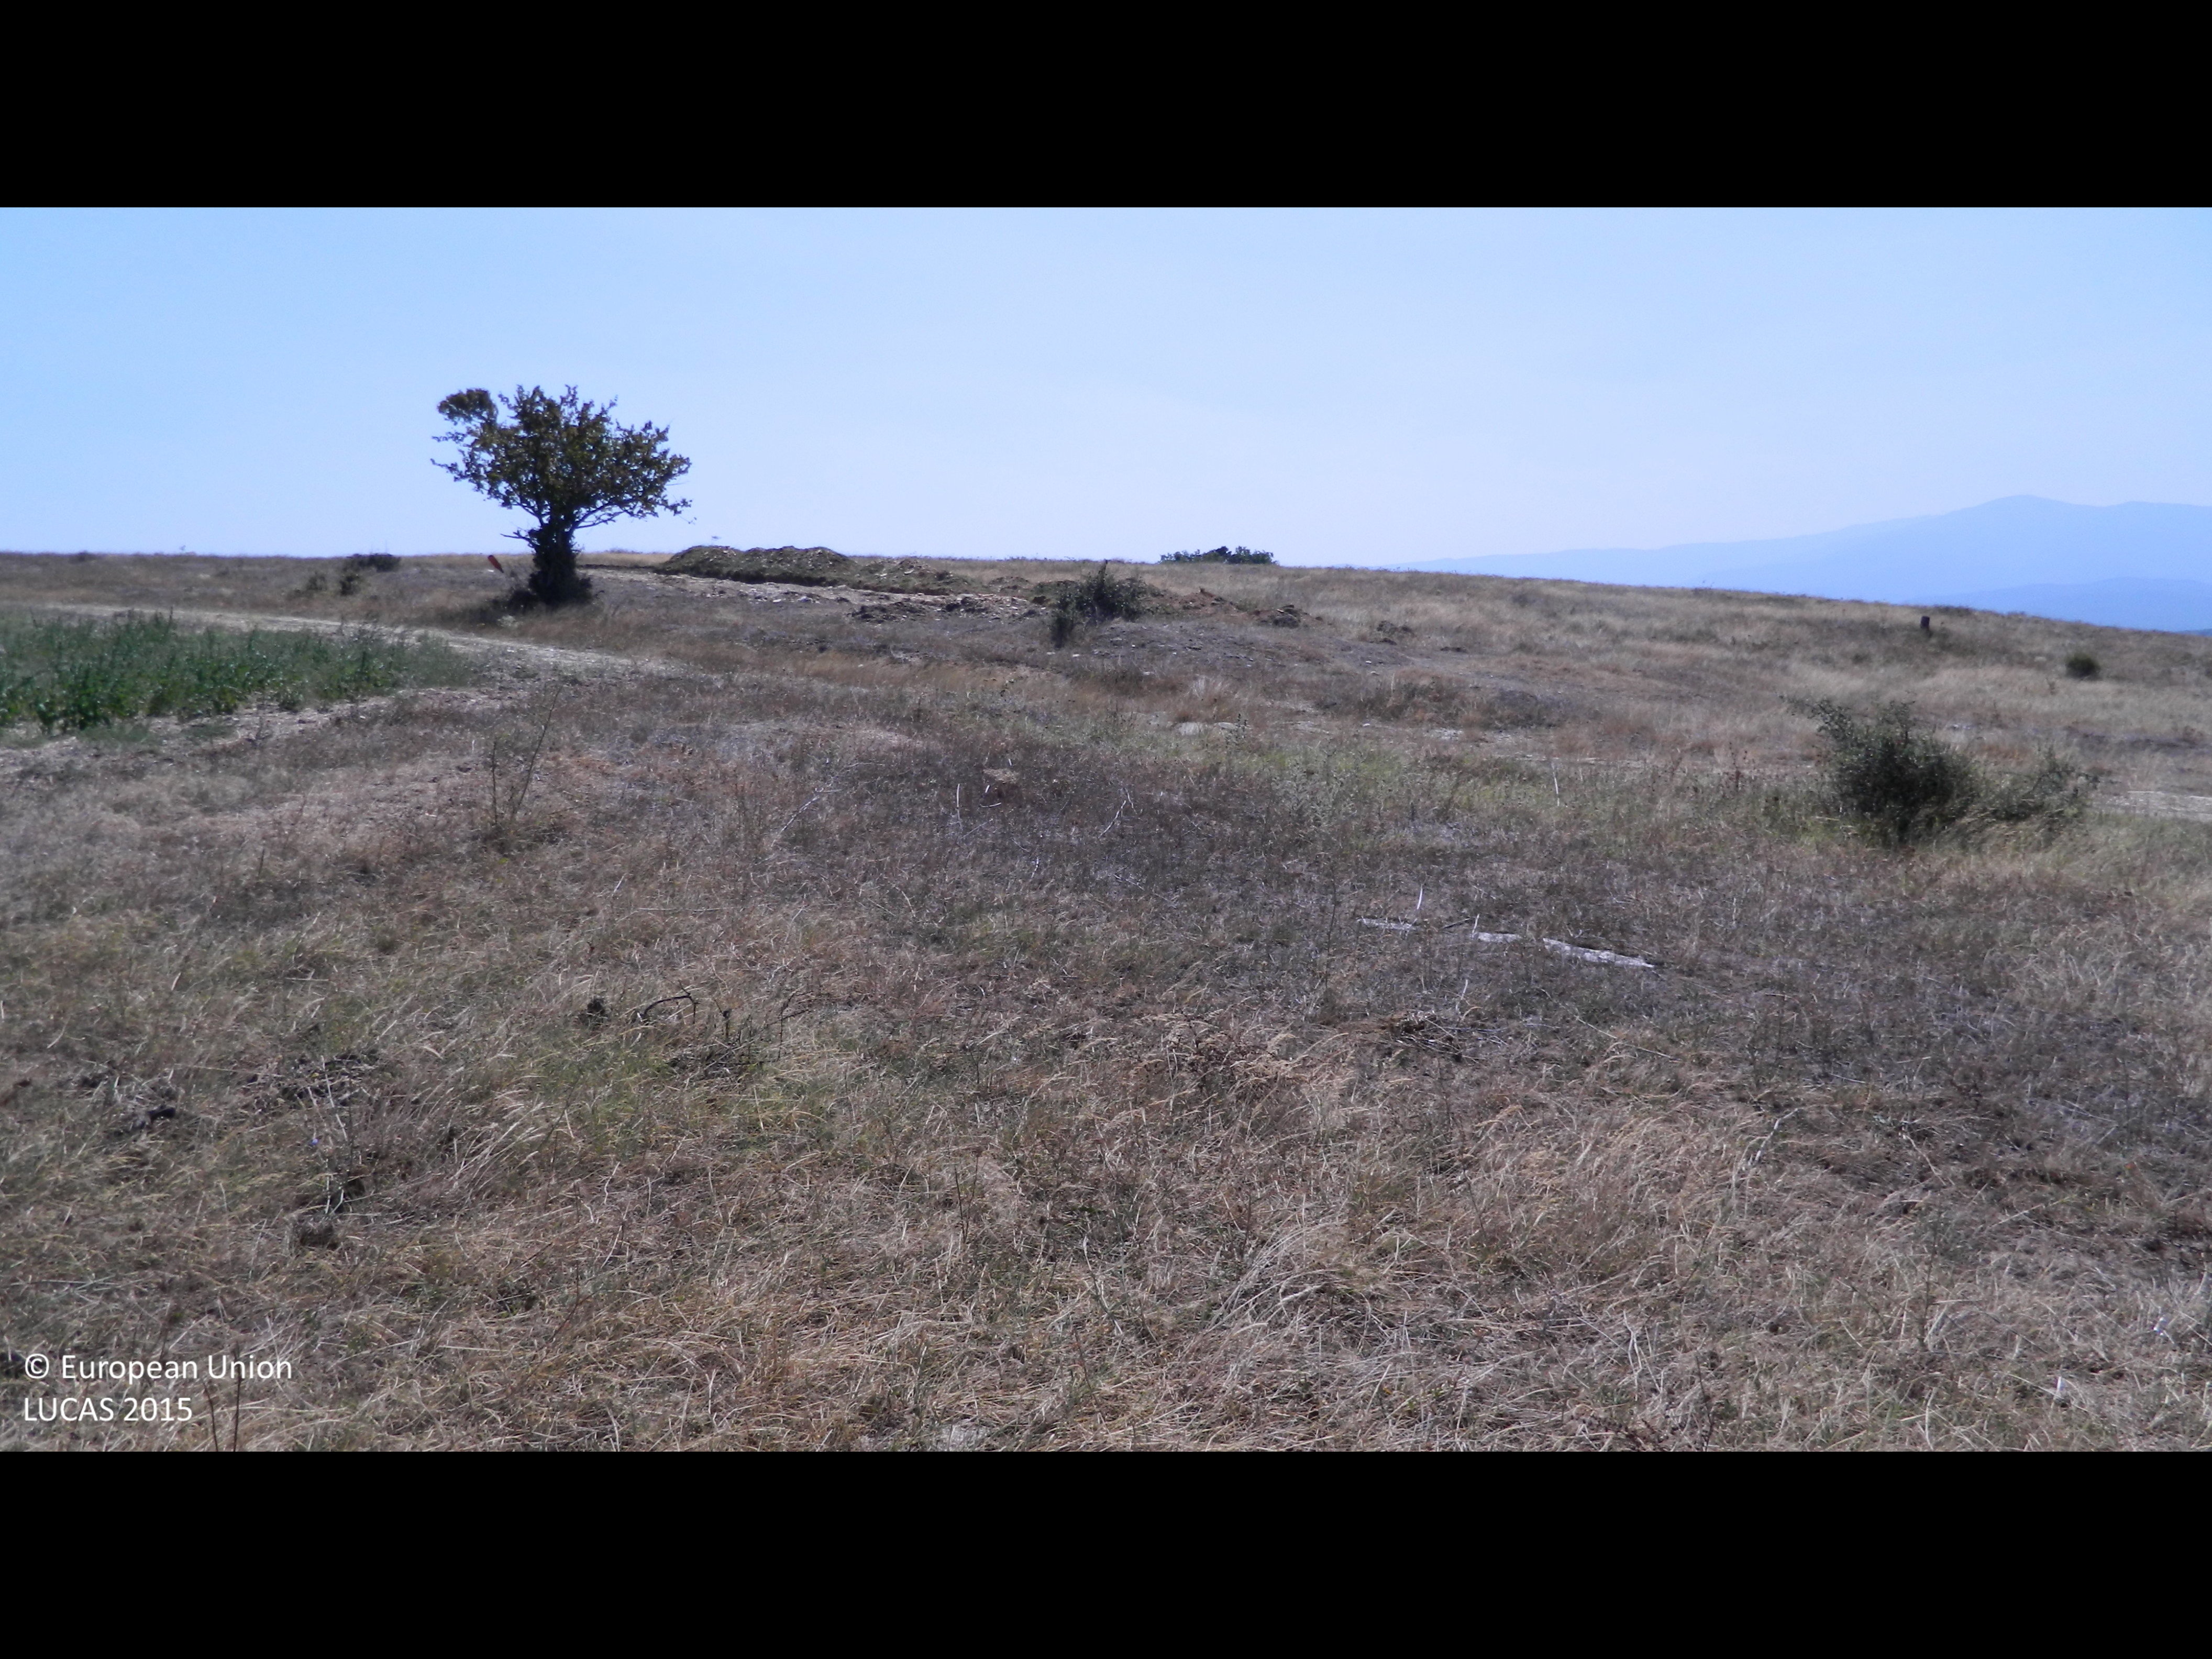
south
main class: Grassland
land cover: Grassland without tree/shrub cover
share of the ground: > 75 %
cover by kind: herbaceous plants 95 %, shrubs 5 %
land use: Agriculture (excluding fallow land and kitchen gardens)
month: August
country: BG
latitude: 41.4753
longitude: 25.9327
